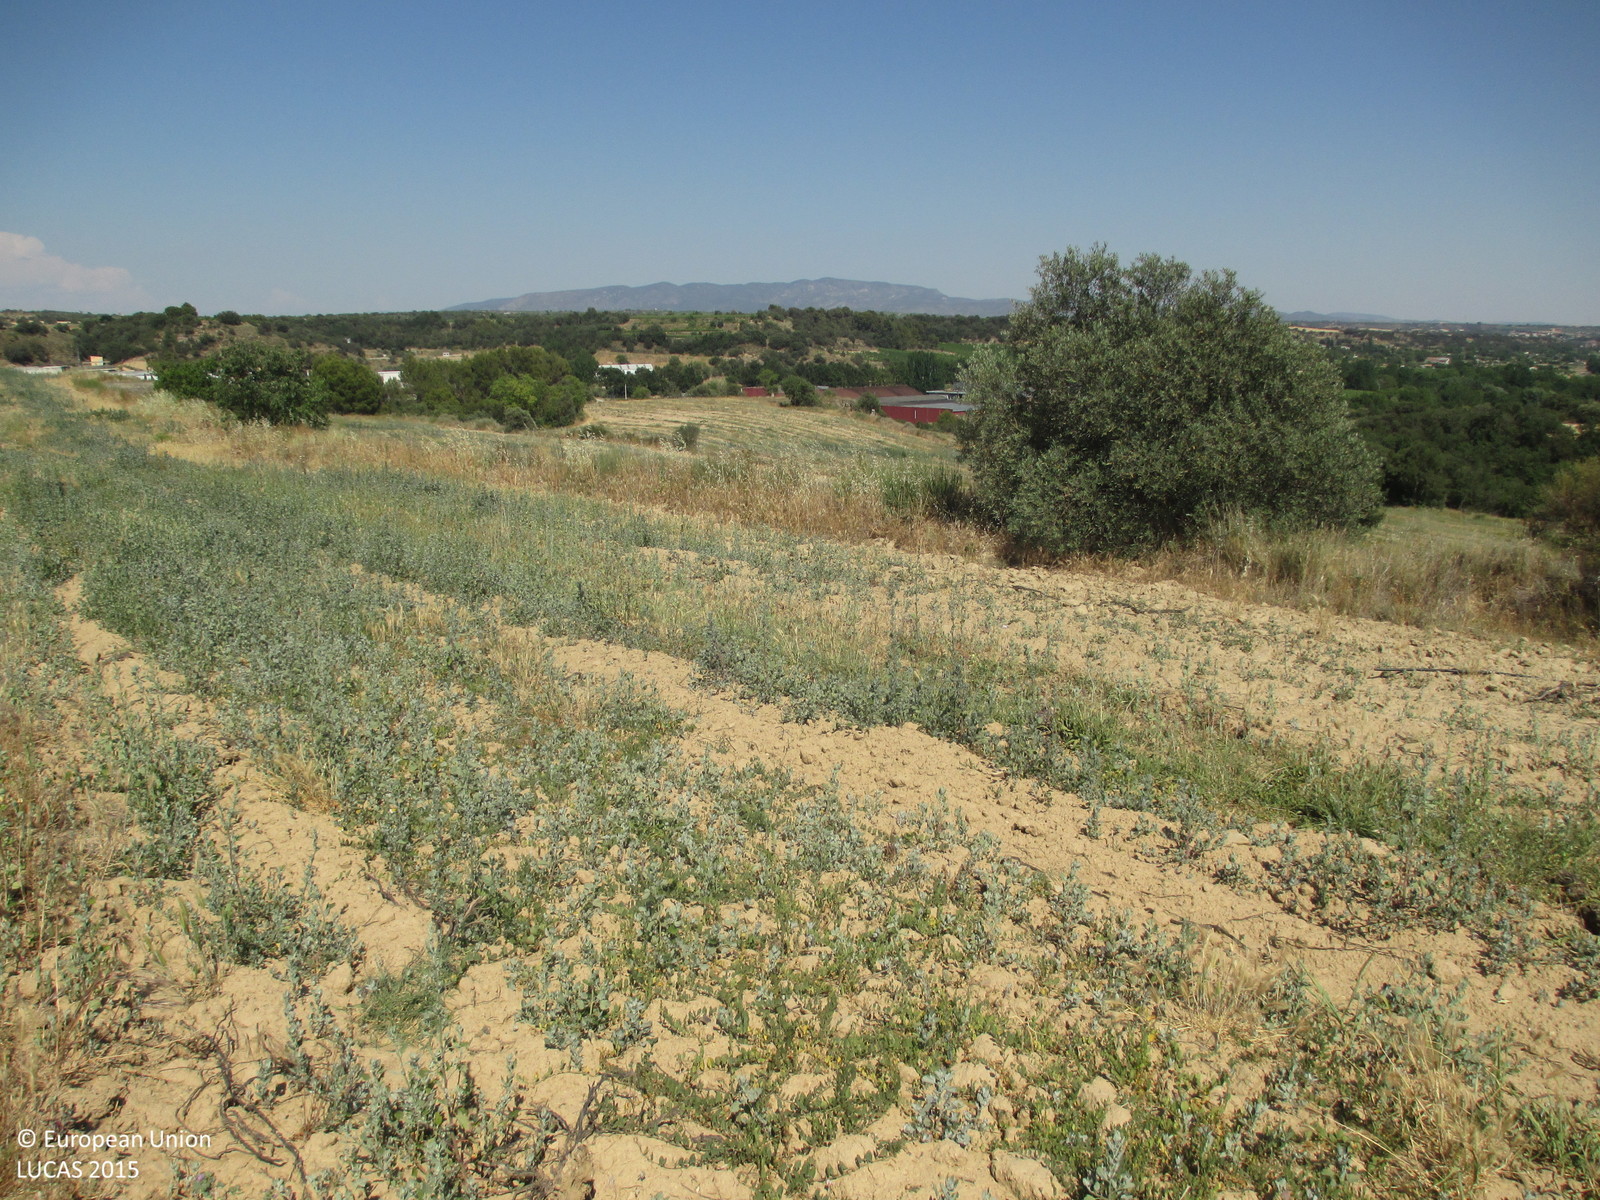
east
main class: Grassland
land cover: Spontaneously vegetated surfaces
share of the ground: 50 - 75 %
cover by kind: herbaceous plants 70 %, unconsolidated bare surface 30 %
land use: Fallow land
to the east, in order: Spontaneously vegetated surfaces; Shrubland with sparse tree cover; Spontaneously vegetated surfaces; Shrubland with sparse tree cover; Spontaneously vegetated surfaces; Shrubland with sparse tree cover; Spontaneously vegetated surfaces; Shrubland without tree cover
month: June
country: ES
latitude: 42.0573
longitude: 0.0848
